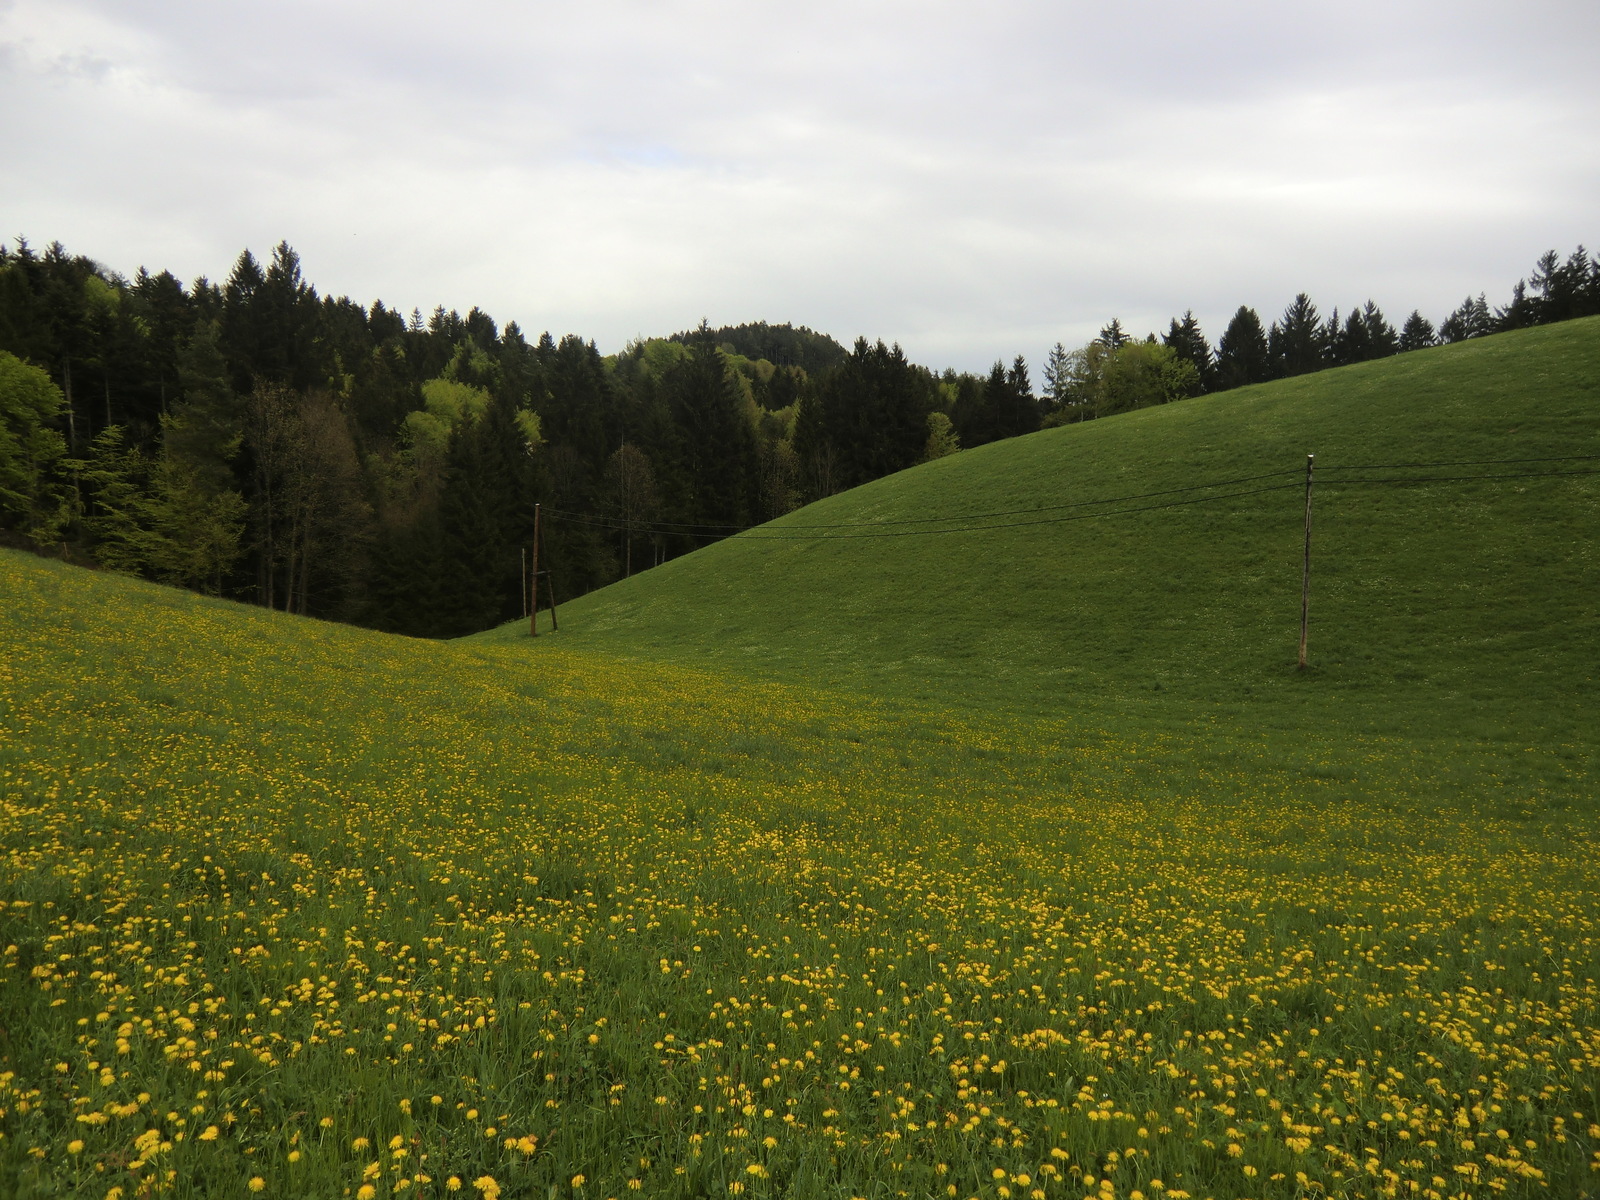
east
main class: Grassland
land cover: Grassland without tree/shrub cover
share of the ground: > 75 %
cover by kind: herbaceous plants 100 %
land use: Agriculture (excluding fallow land and kitchen gardens)
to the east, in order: Grassland without tree/shrub cover; Electric lines; Grassland without tree/shrub cover; Fences; Spruce dominated mixed woodland; Tracks; Electric lines; Spruce dominated mixed woodland; Rivers and streams; Spruce dominated mixed woodland; Broadleaved woodland
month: May
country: AT
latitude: 48.3526
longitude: 14.8186
